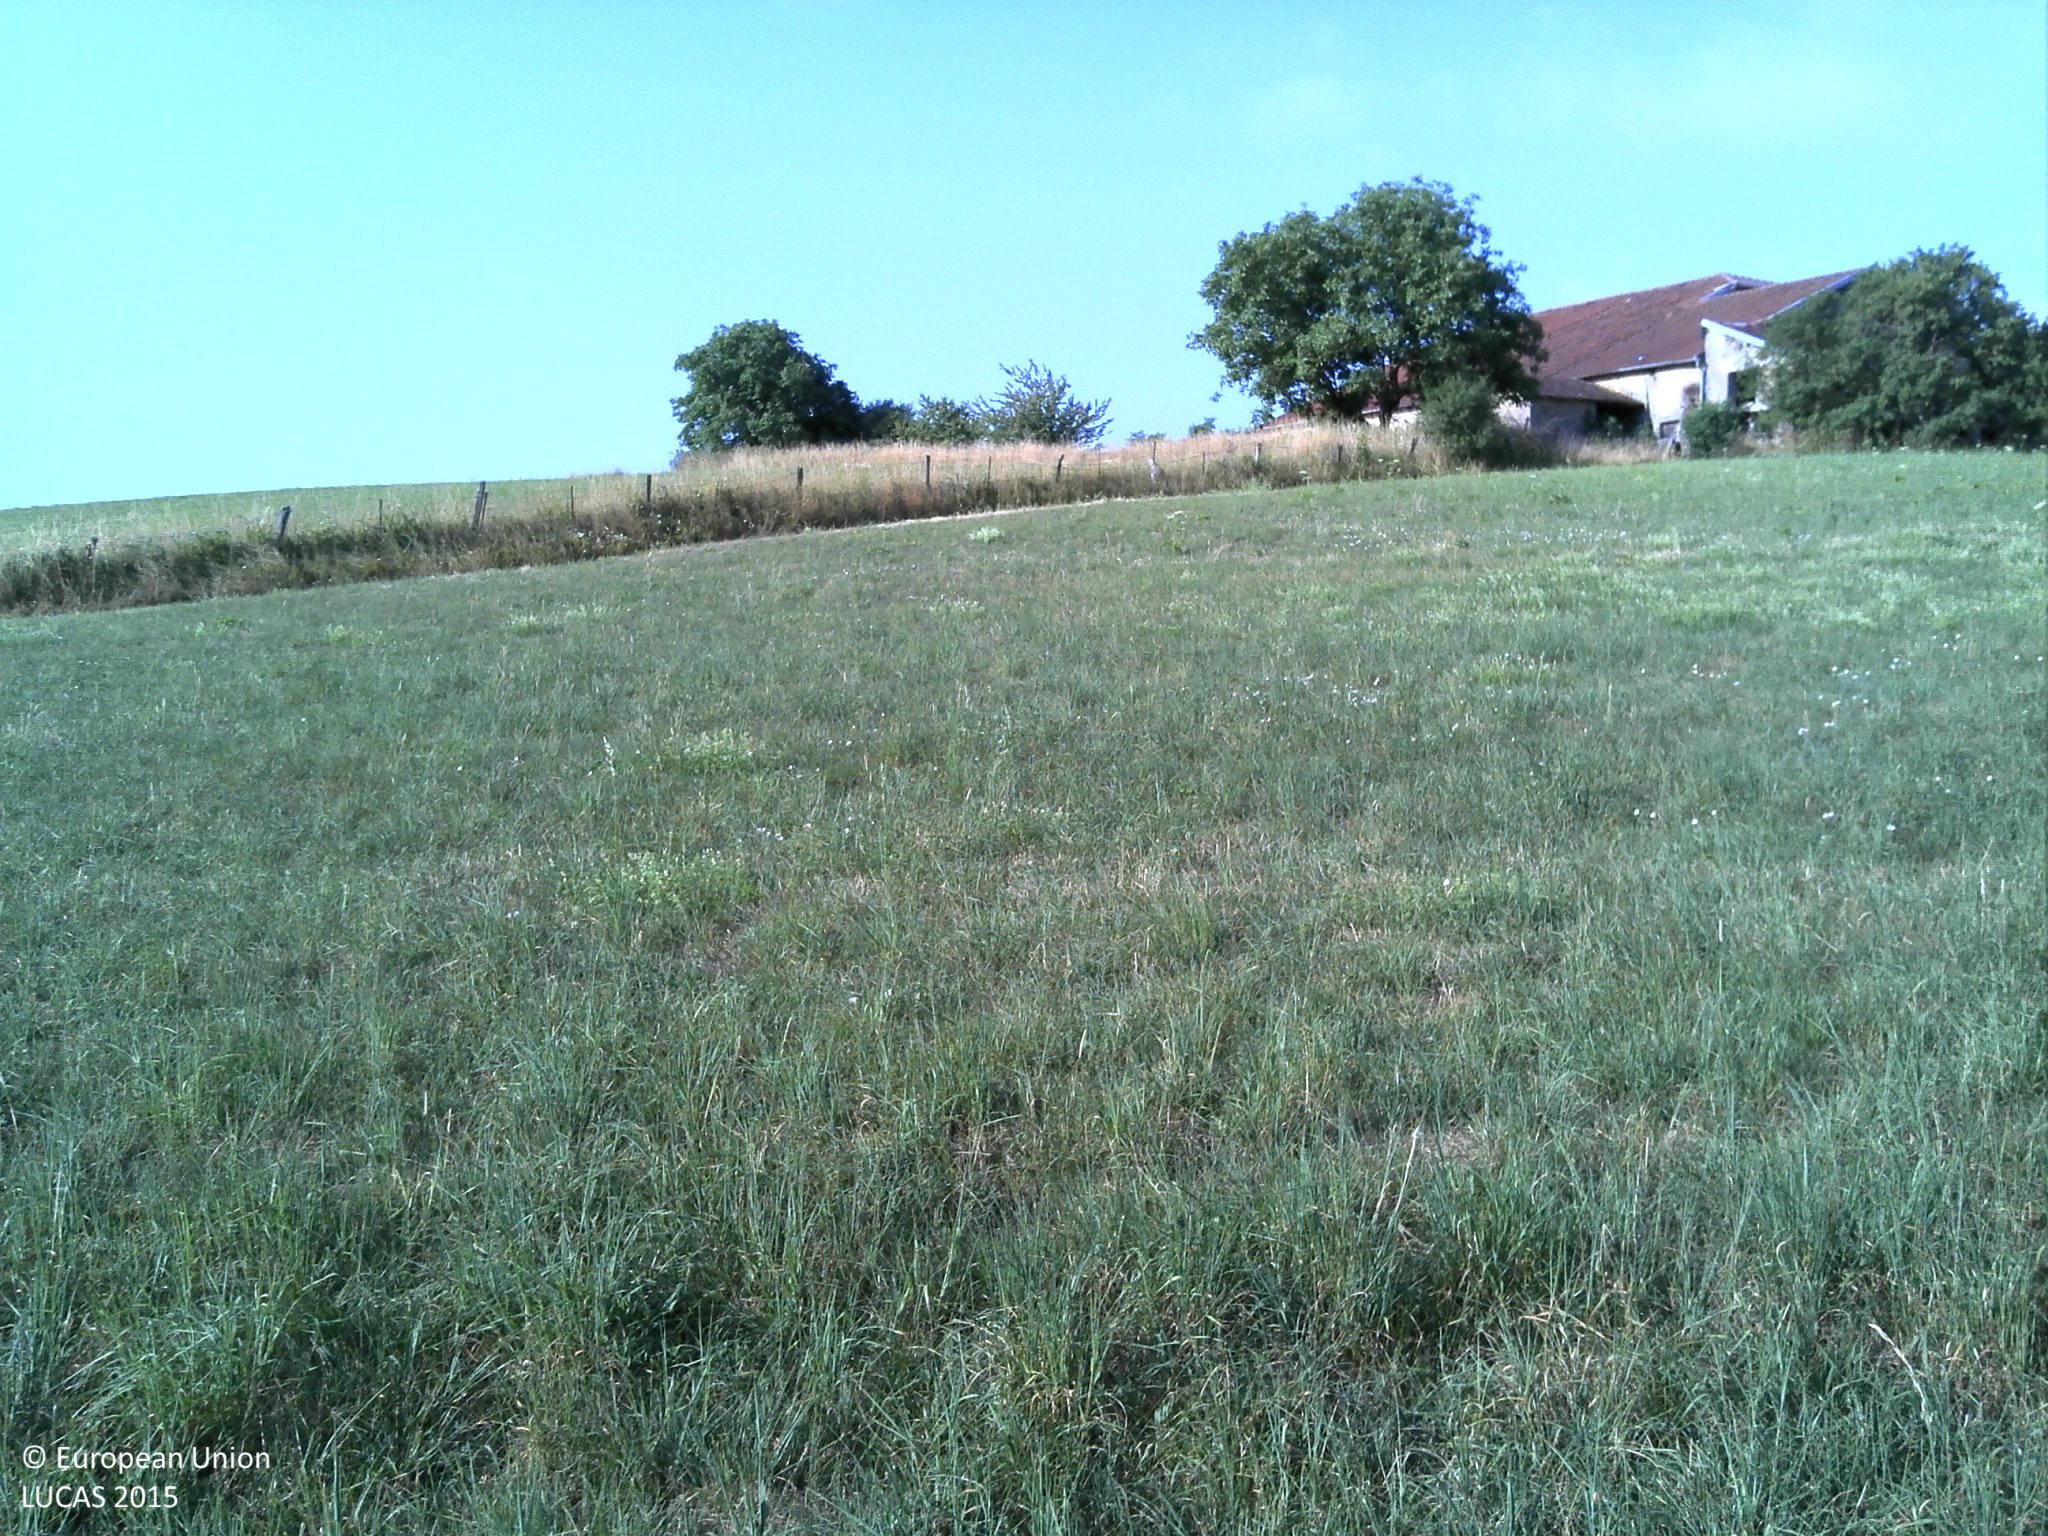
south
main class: Grassland
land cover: Grassland without tree/shrub cover
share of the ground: > 75 %
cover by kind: herbaceous plants 100 %
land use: Agriculture (excluding fallow land and kitchen gardens)
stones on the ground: 10 - 25 %
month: July
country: FR
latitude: 48.1796
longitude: 6.3021
